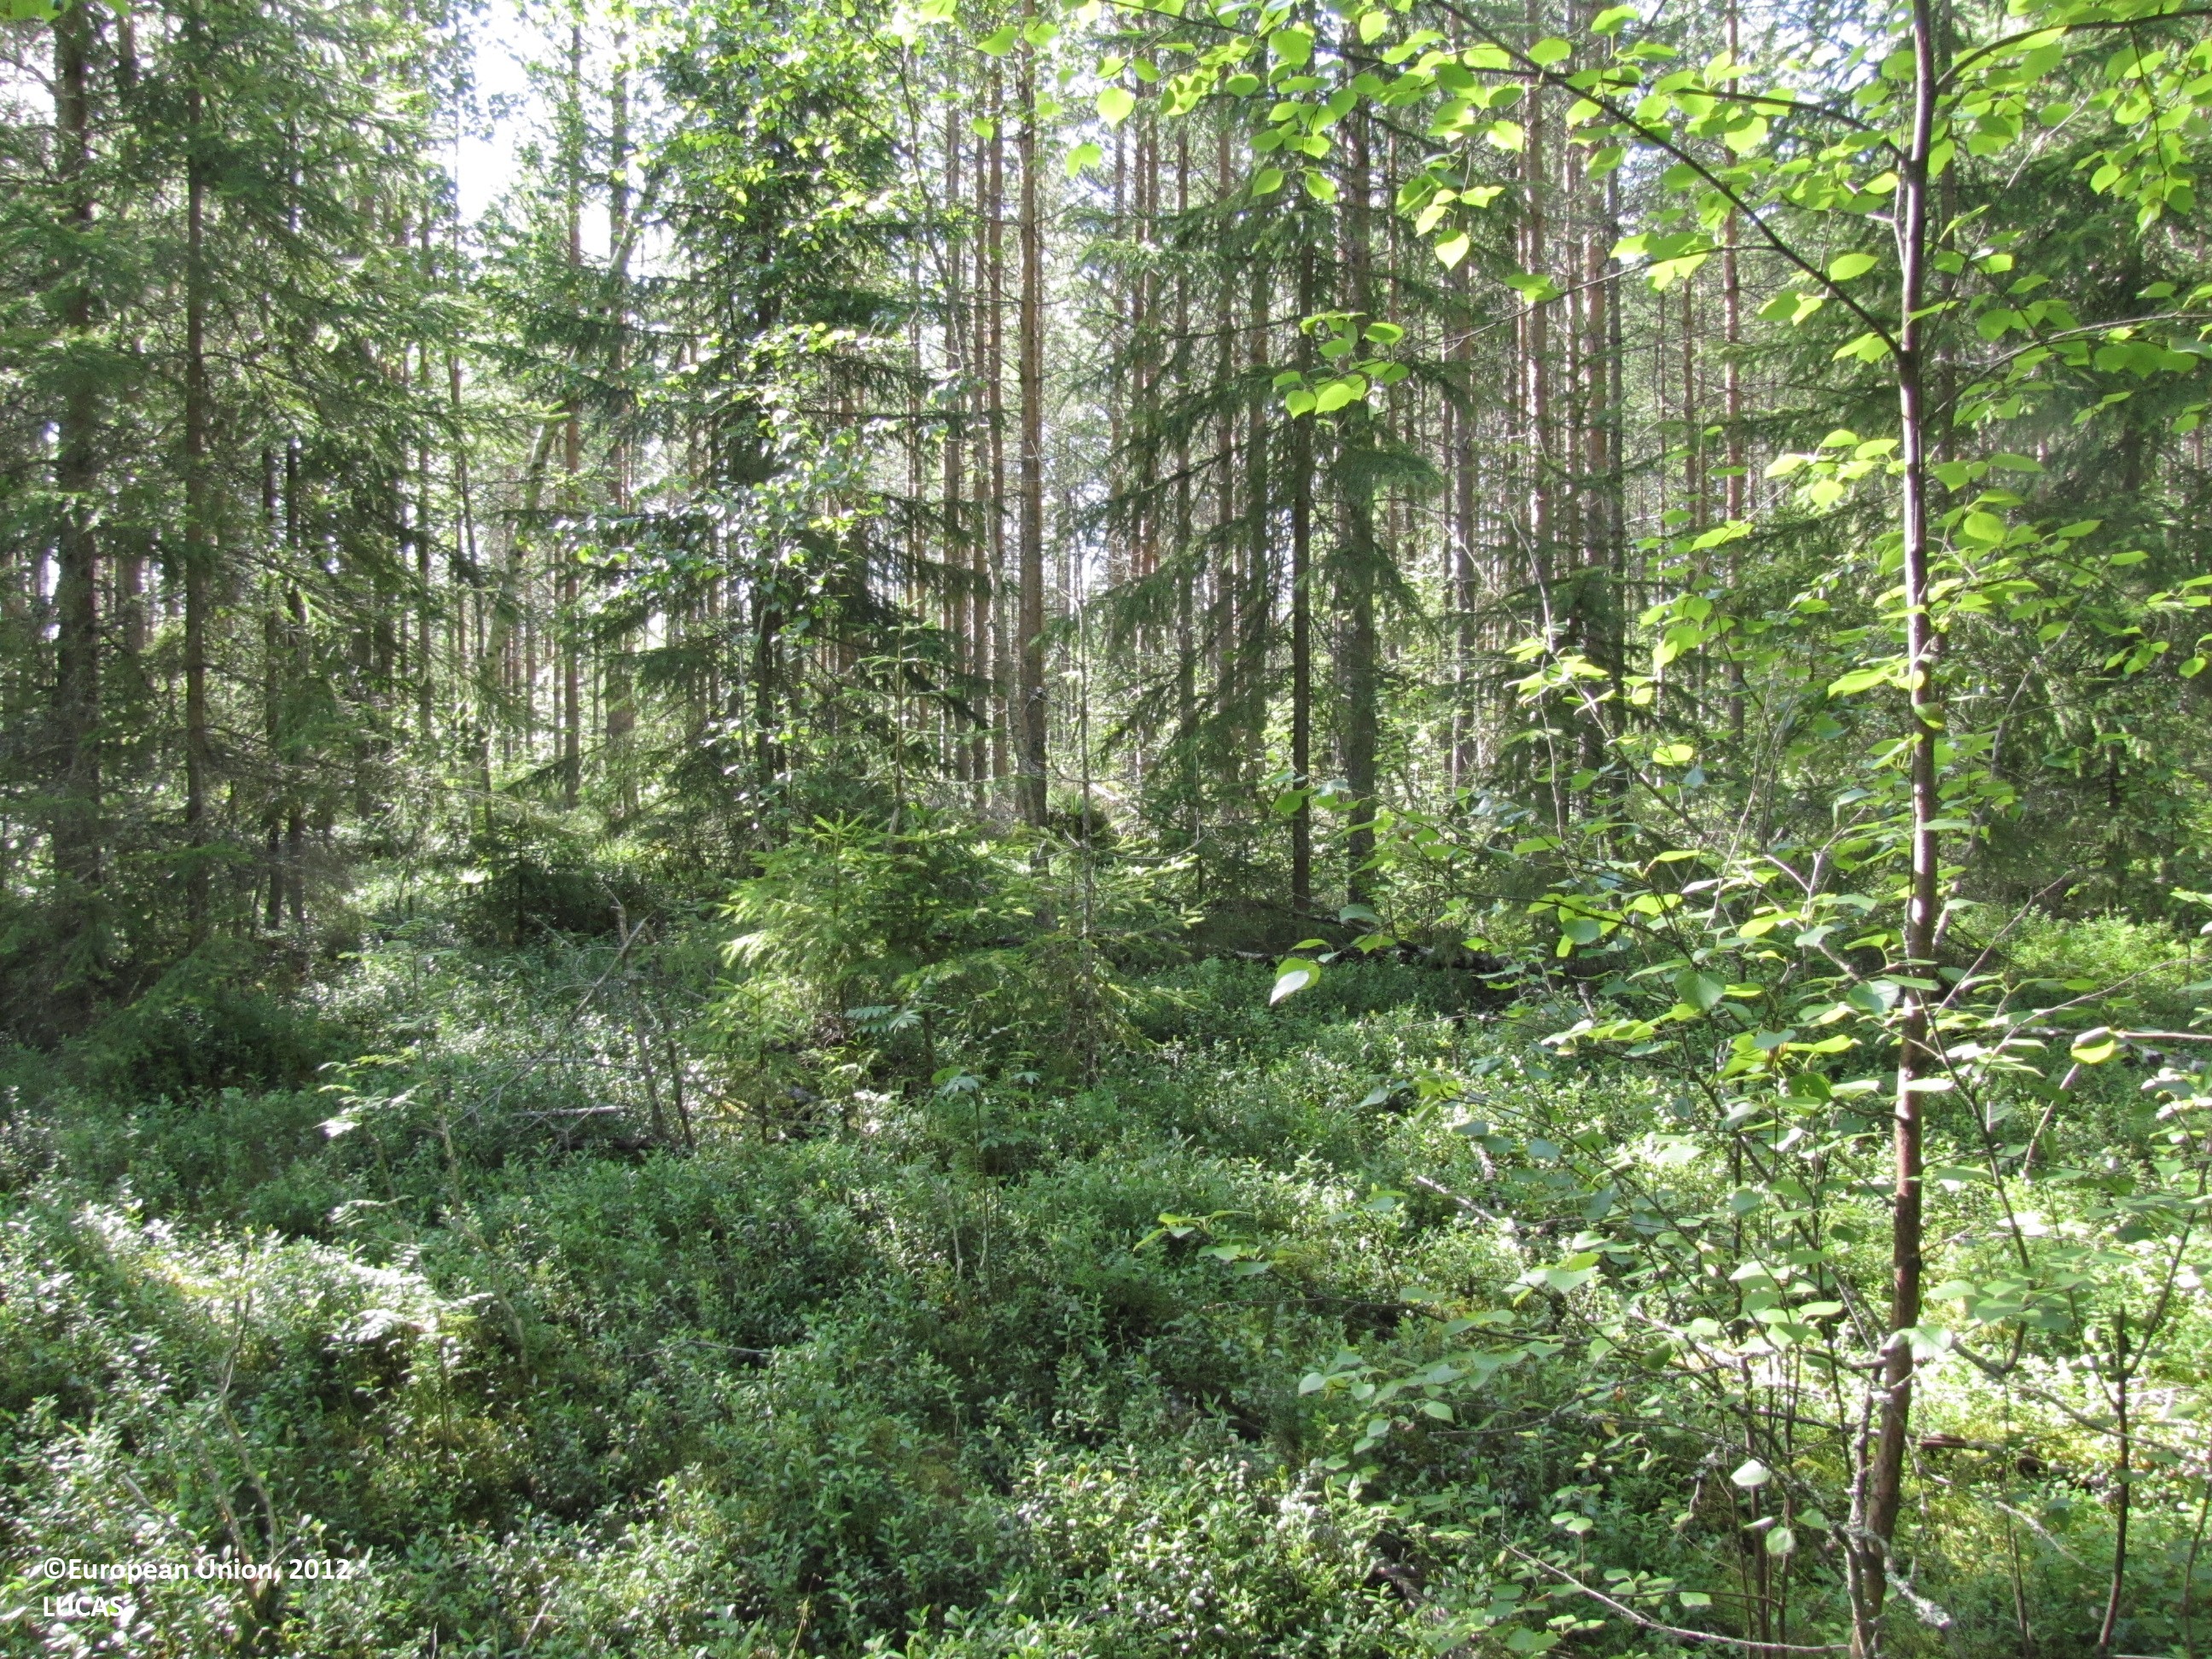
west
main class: Woodland
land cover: Pine dominated coniferous woodland
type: boreal forest
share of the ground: > 75 %
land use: Forestry
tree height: > 5 m
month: July
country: FI
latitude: 62.3515
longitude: 23.0654
